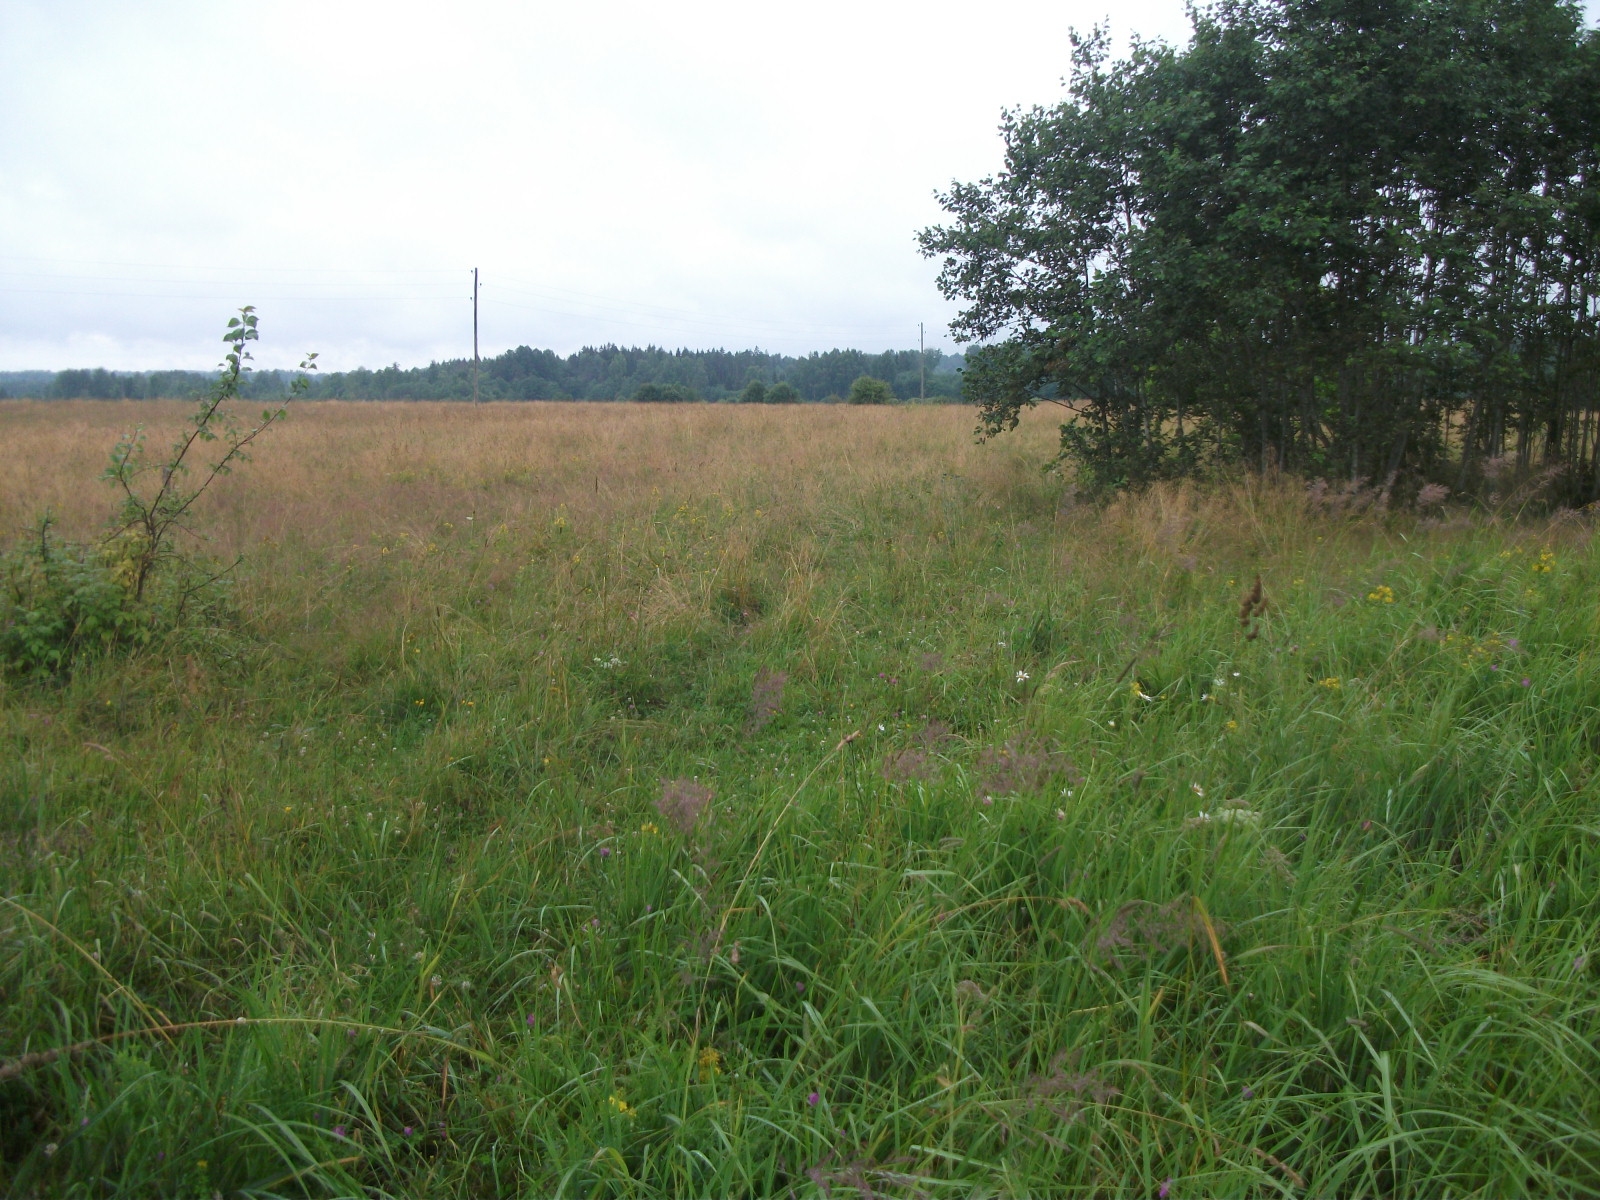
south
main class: Grassland
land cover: Grassland with sparse tree/shrub cover
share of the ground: > 75 %
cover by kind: herbaceous plants 90 %, broadleaved forest trees 5 %, shrubs 5 %
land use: Agriculture (excluding fallow land and kitchen gardens)
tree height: < 5 m
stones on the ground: < 10 %
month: July
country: LV
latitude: 56.7847
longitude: 25.7572
